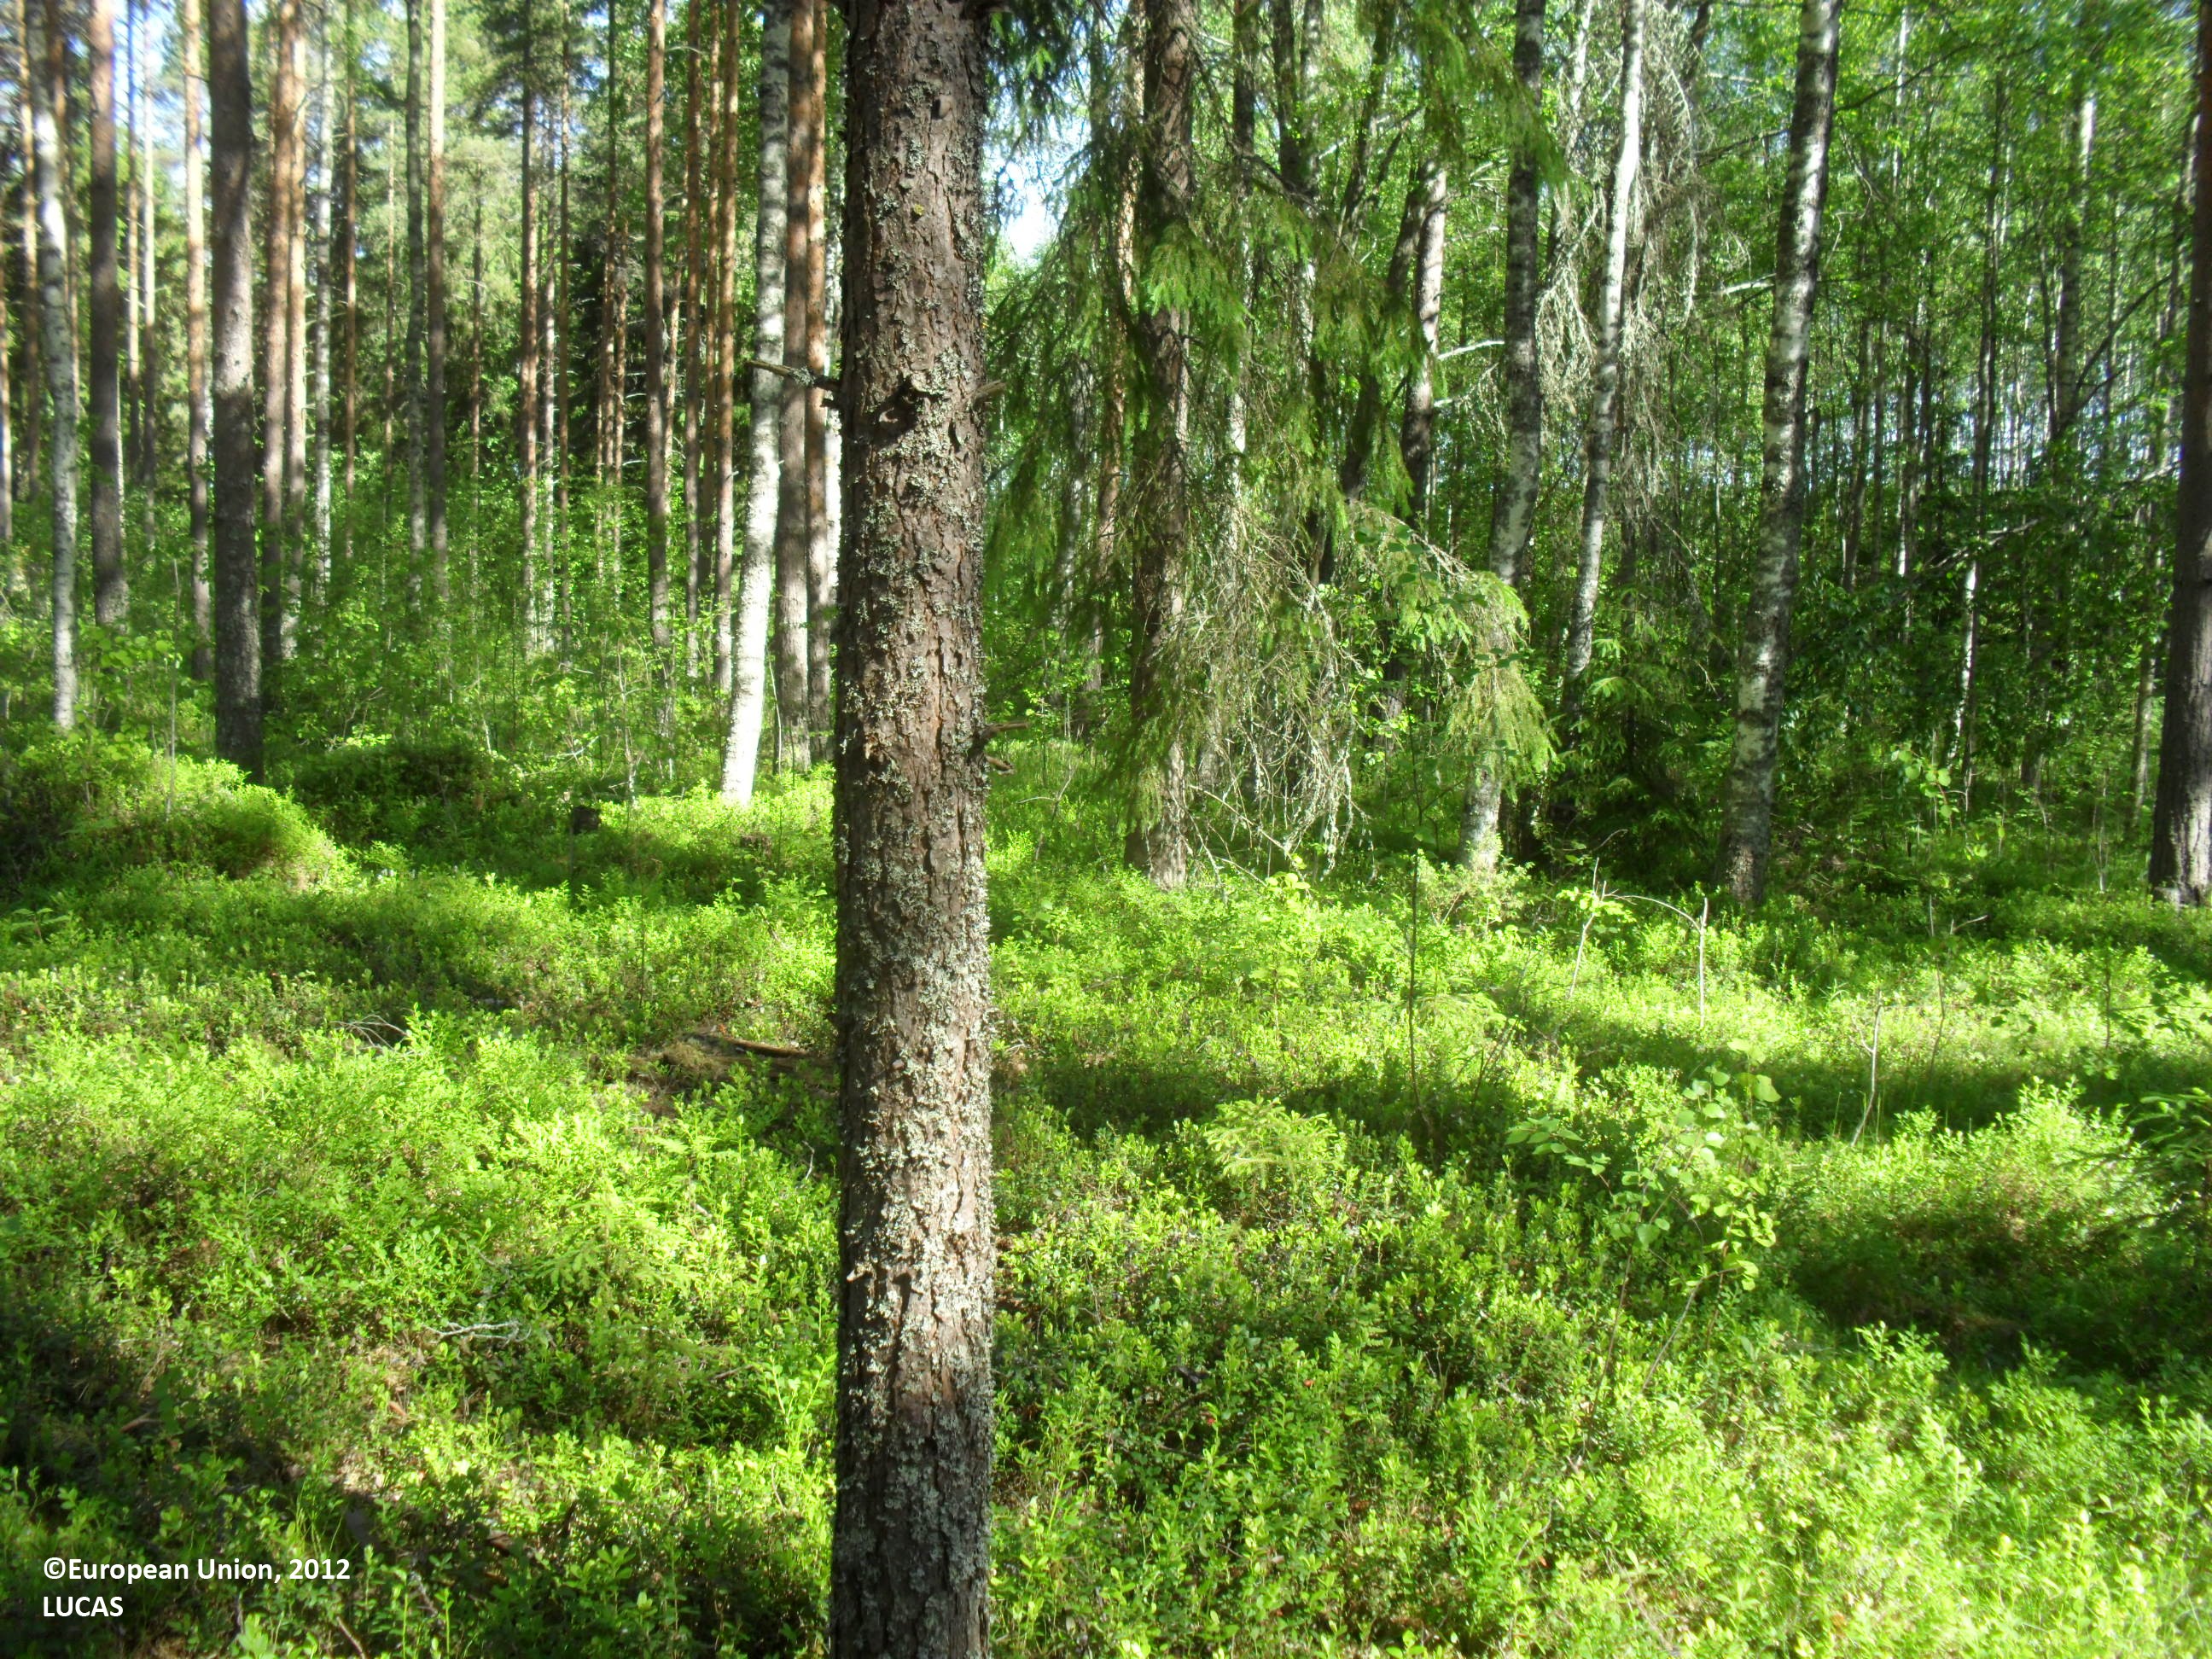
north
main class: Woodland
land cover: Other mixed woodland
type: boreal forest
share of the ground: 25 - 50 %
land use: Forestry
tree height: > 5 m
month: June
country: FI
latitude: 63.2248
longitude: 22.9289
